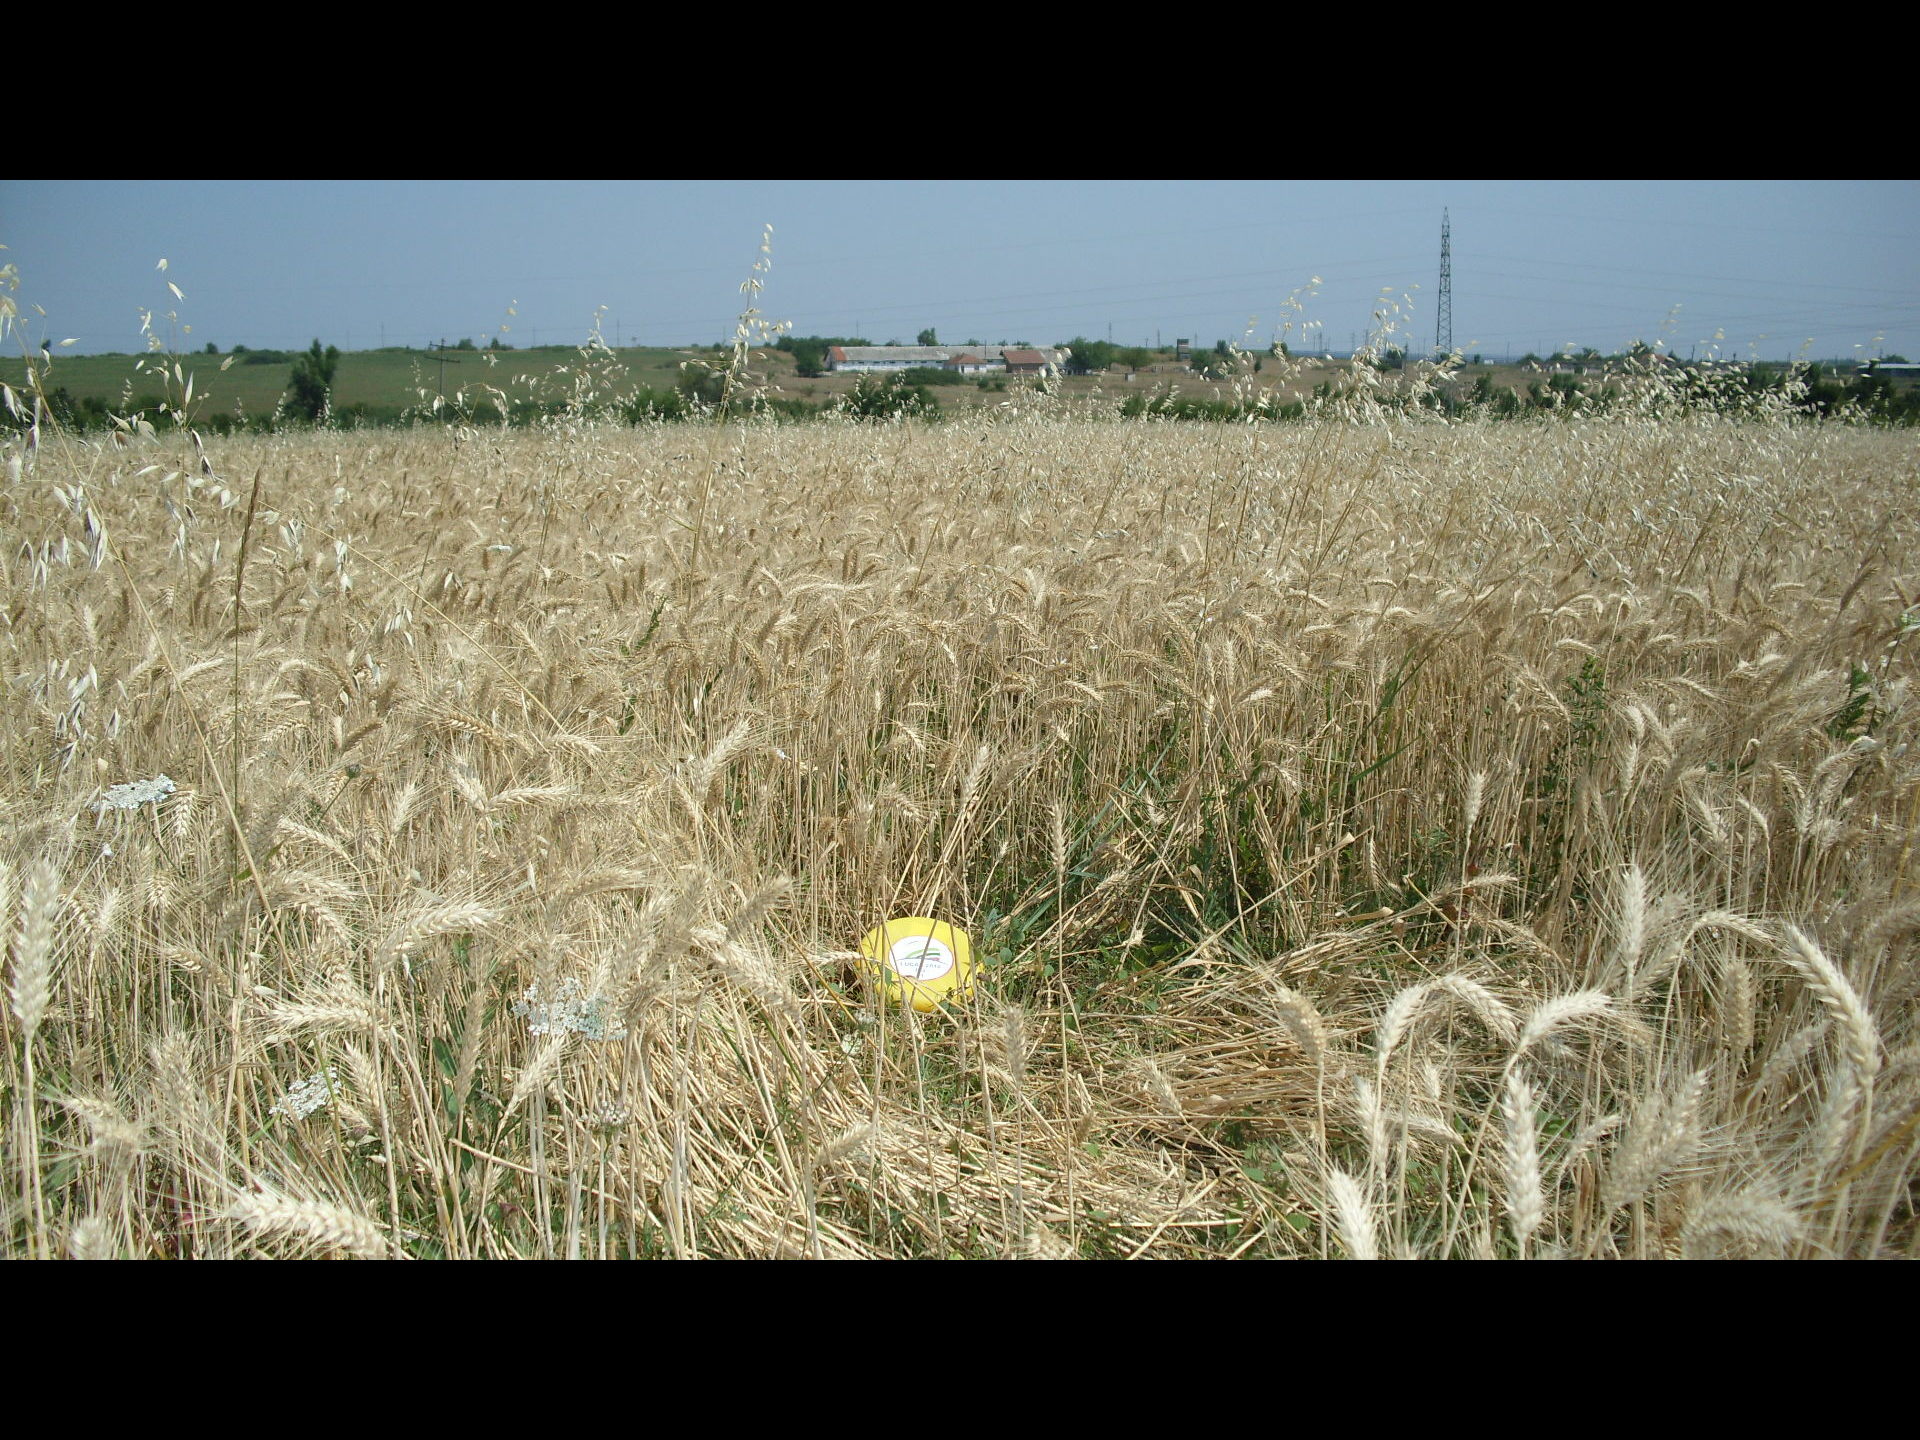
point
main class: Cropland
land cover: Common wheat
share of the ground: > 75 %
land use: Agriculture (excluding fallow land and kitchen gardens)
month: July
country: BG
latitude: 43.6494
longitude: 22.7681
